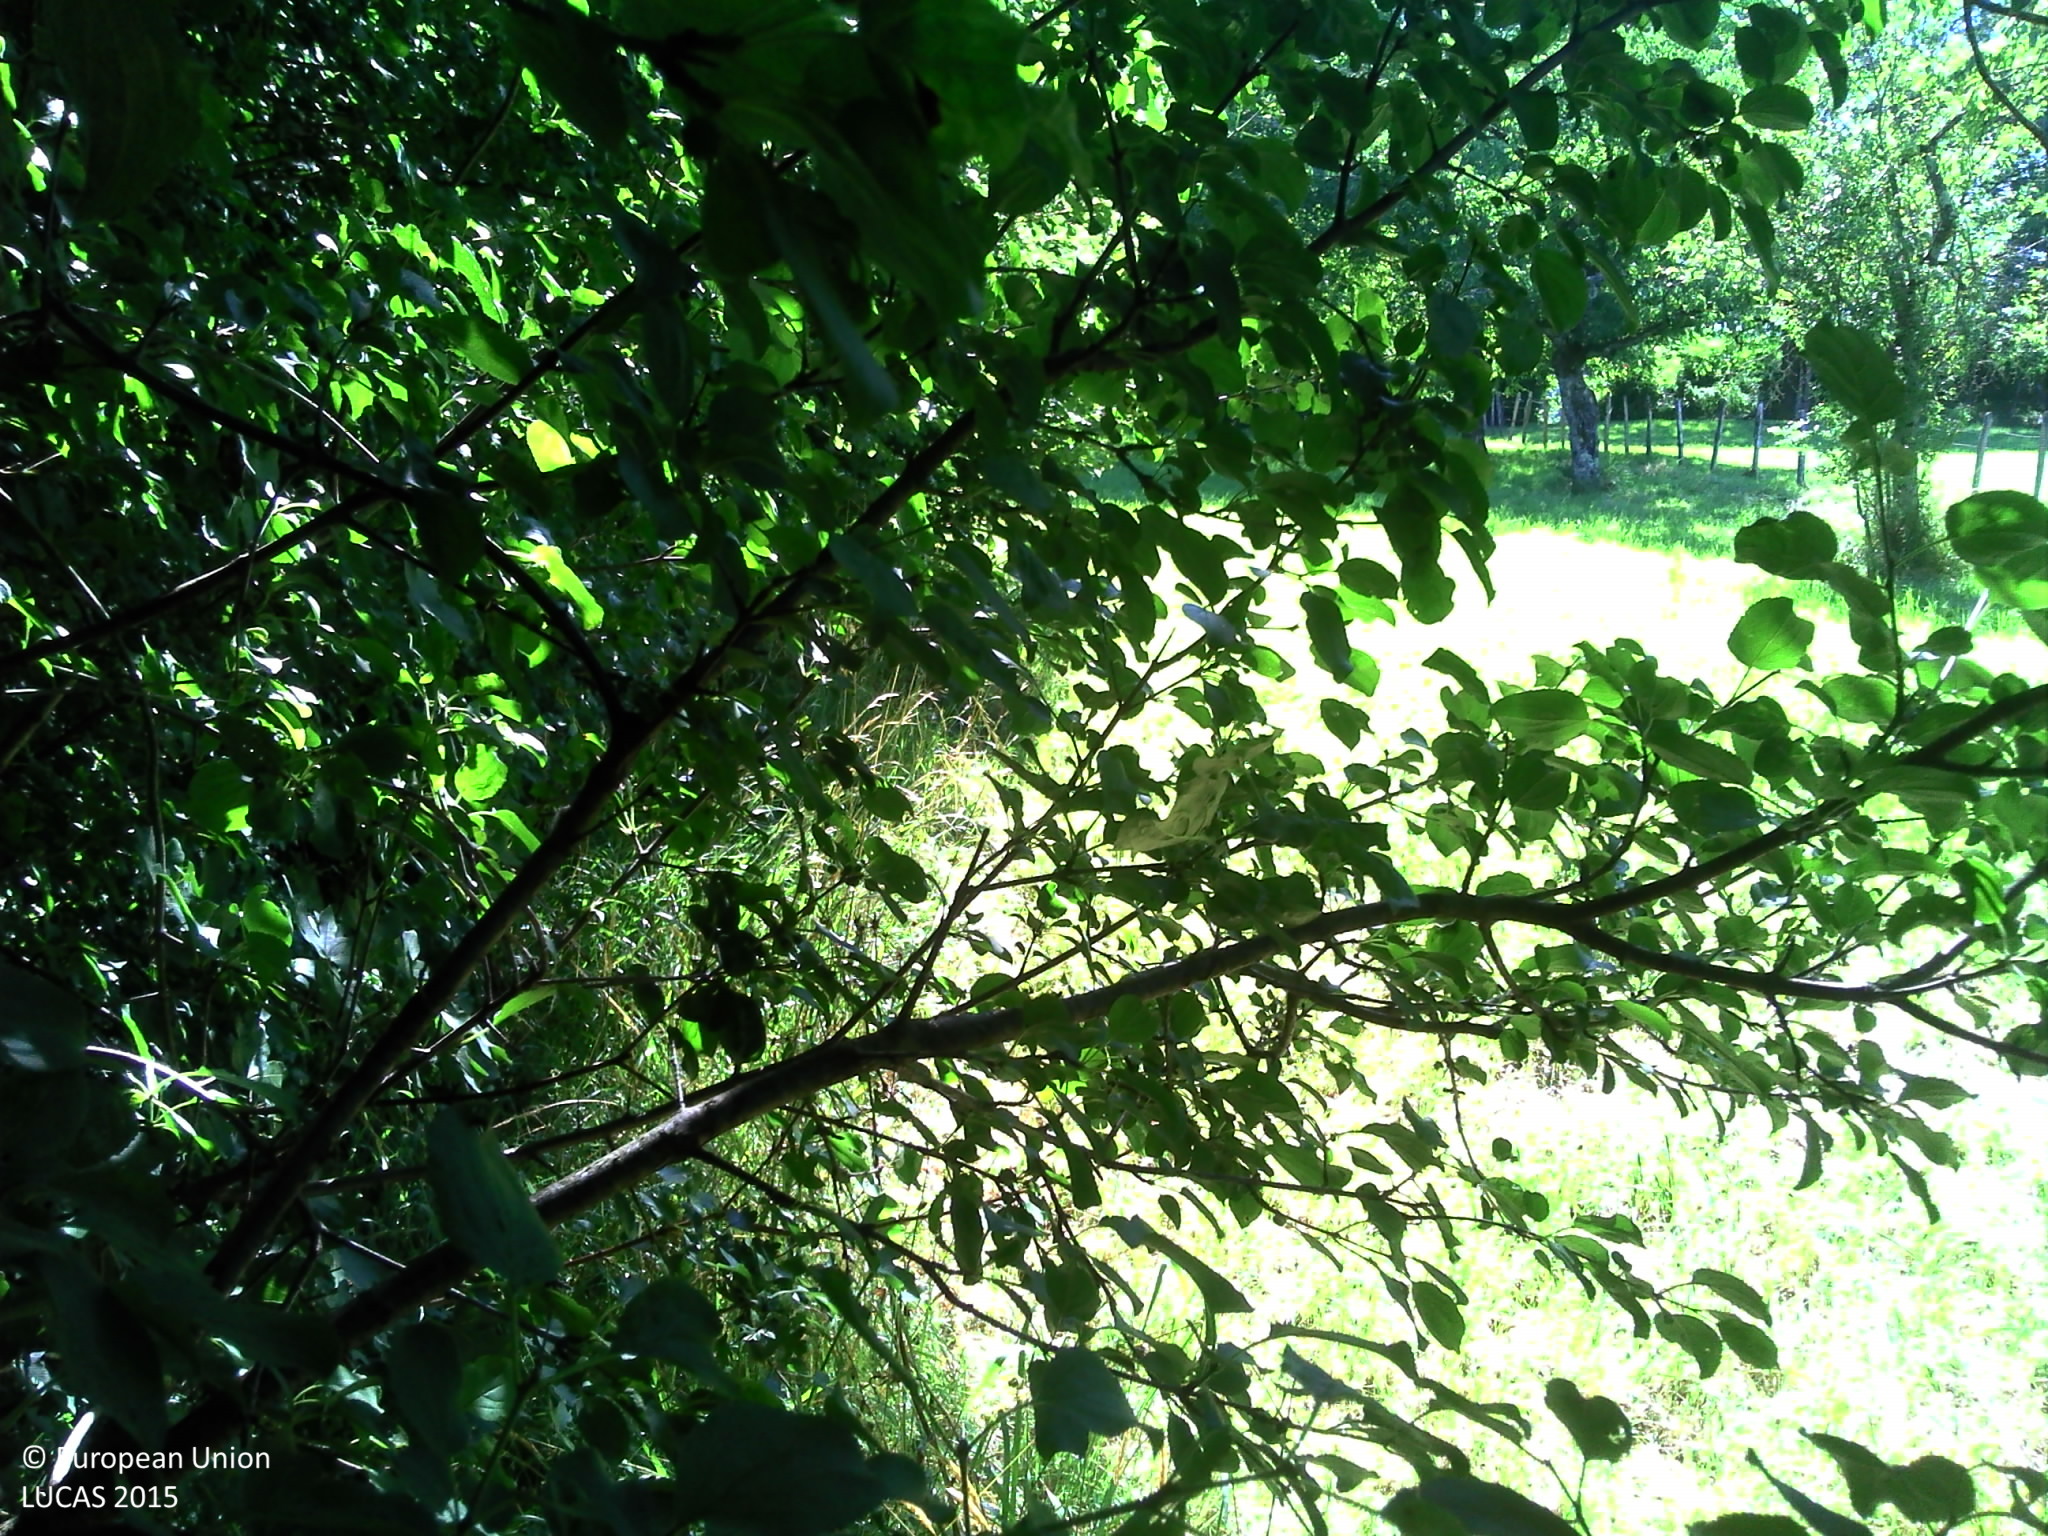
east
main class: Grassland
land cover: Grassland with sparse tree/shrub cover
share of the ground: > 75 %
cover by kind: herbaceous plants 95 %, broadleaved forest trees 5 %
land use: Residential
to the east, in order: Managed hedges; Grassland without tree/shrub cover; Fences; Broadleaved woodland; Artificial constructions in urban areas; Grassland with sparse tree/shrub cover; Fences; Grassland without tree/shrub cover; Managed hedges; Fences; Managed hedges; Grass margins; Tracks; Grass margins; Ditches and canals; Grass margins; Common wheat
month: June
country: FR
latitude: 46.5409
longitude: 5.3993
